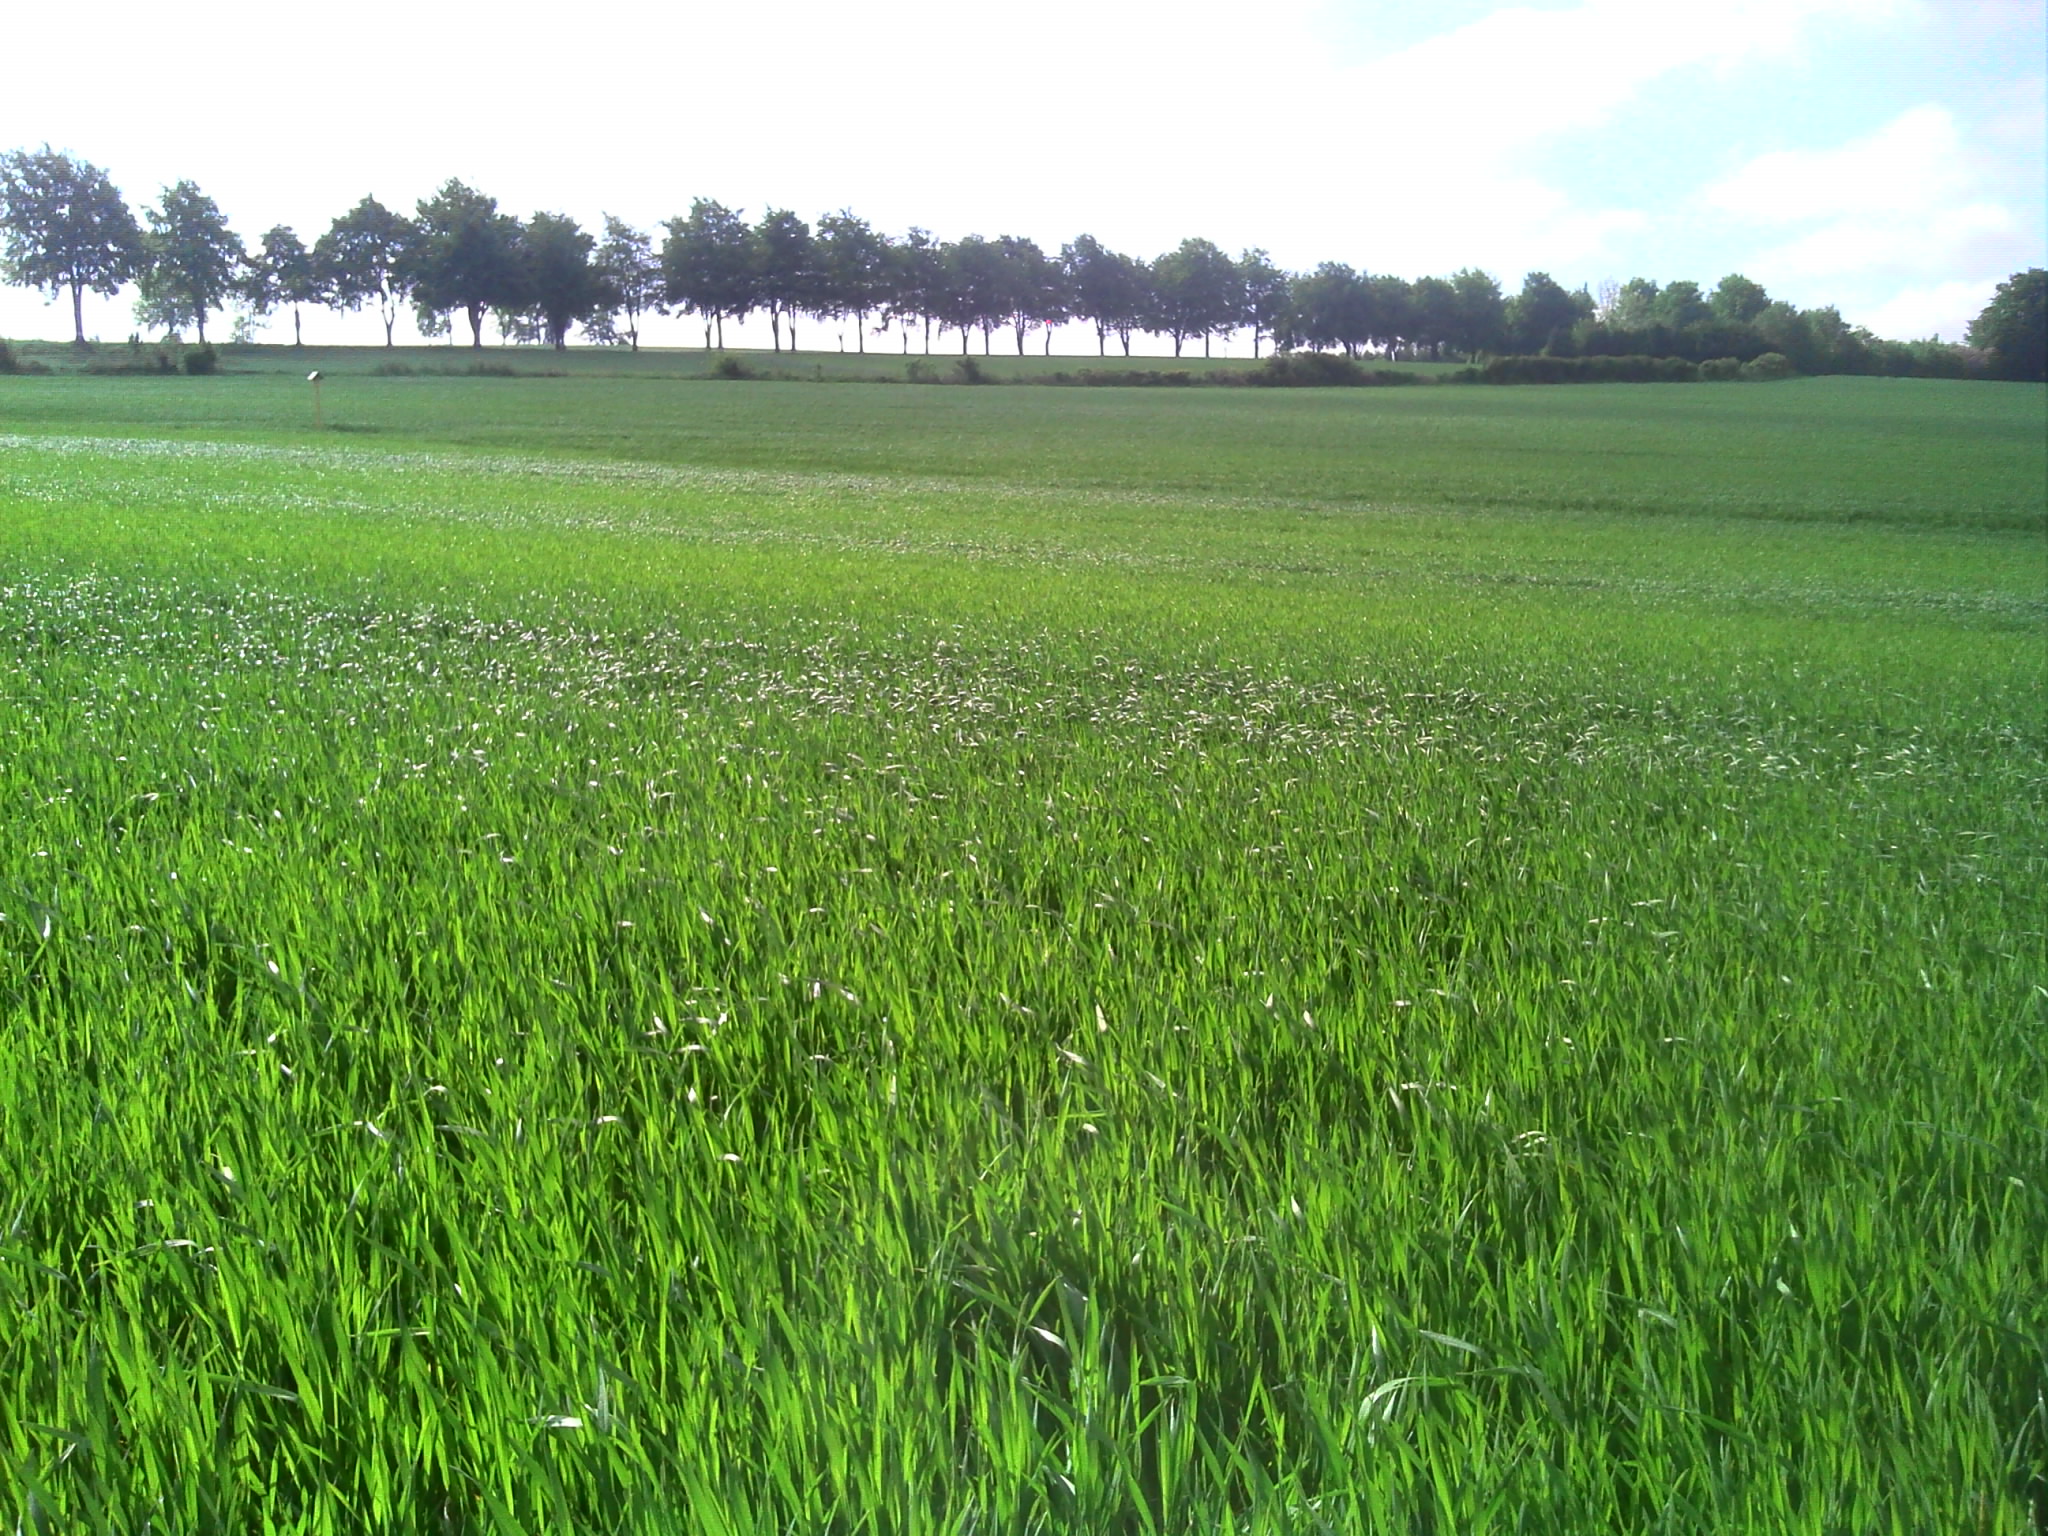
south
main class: Cropland
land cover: Common wheat
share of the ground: > 75 %
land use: Agriculture (excluding fallow land and kitchen gardens)
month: May
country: LU
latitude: 50.0199
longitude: 5.8817
